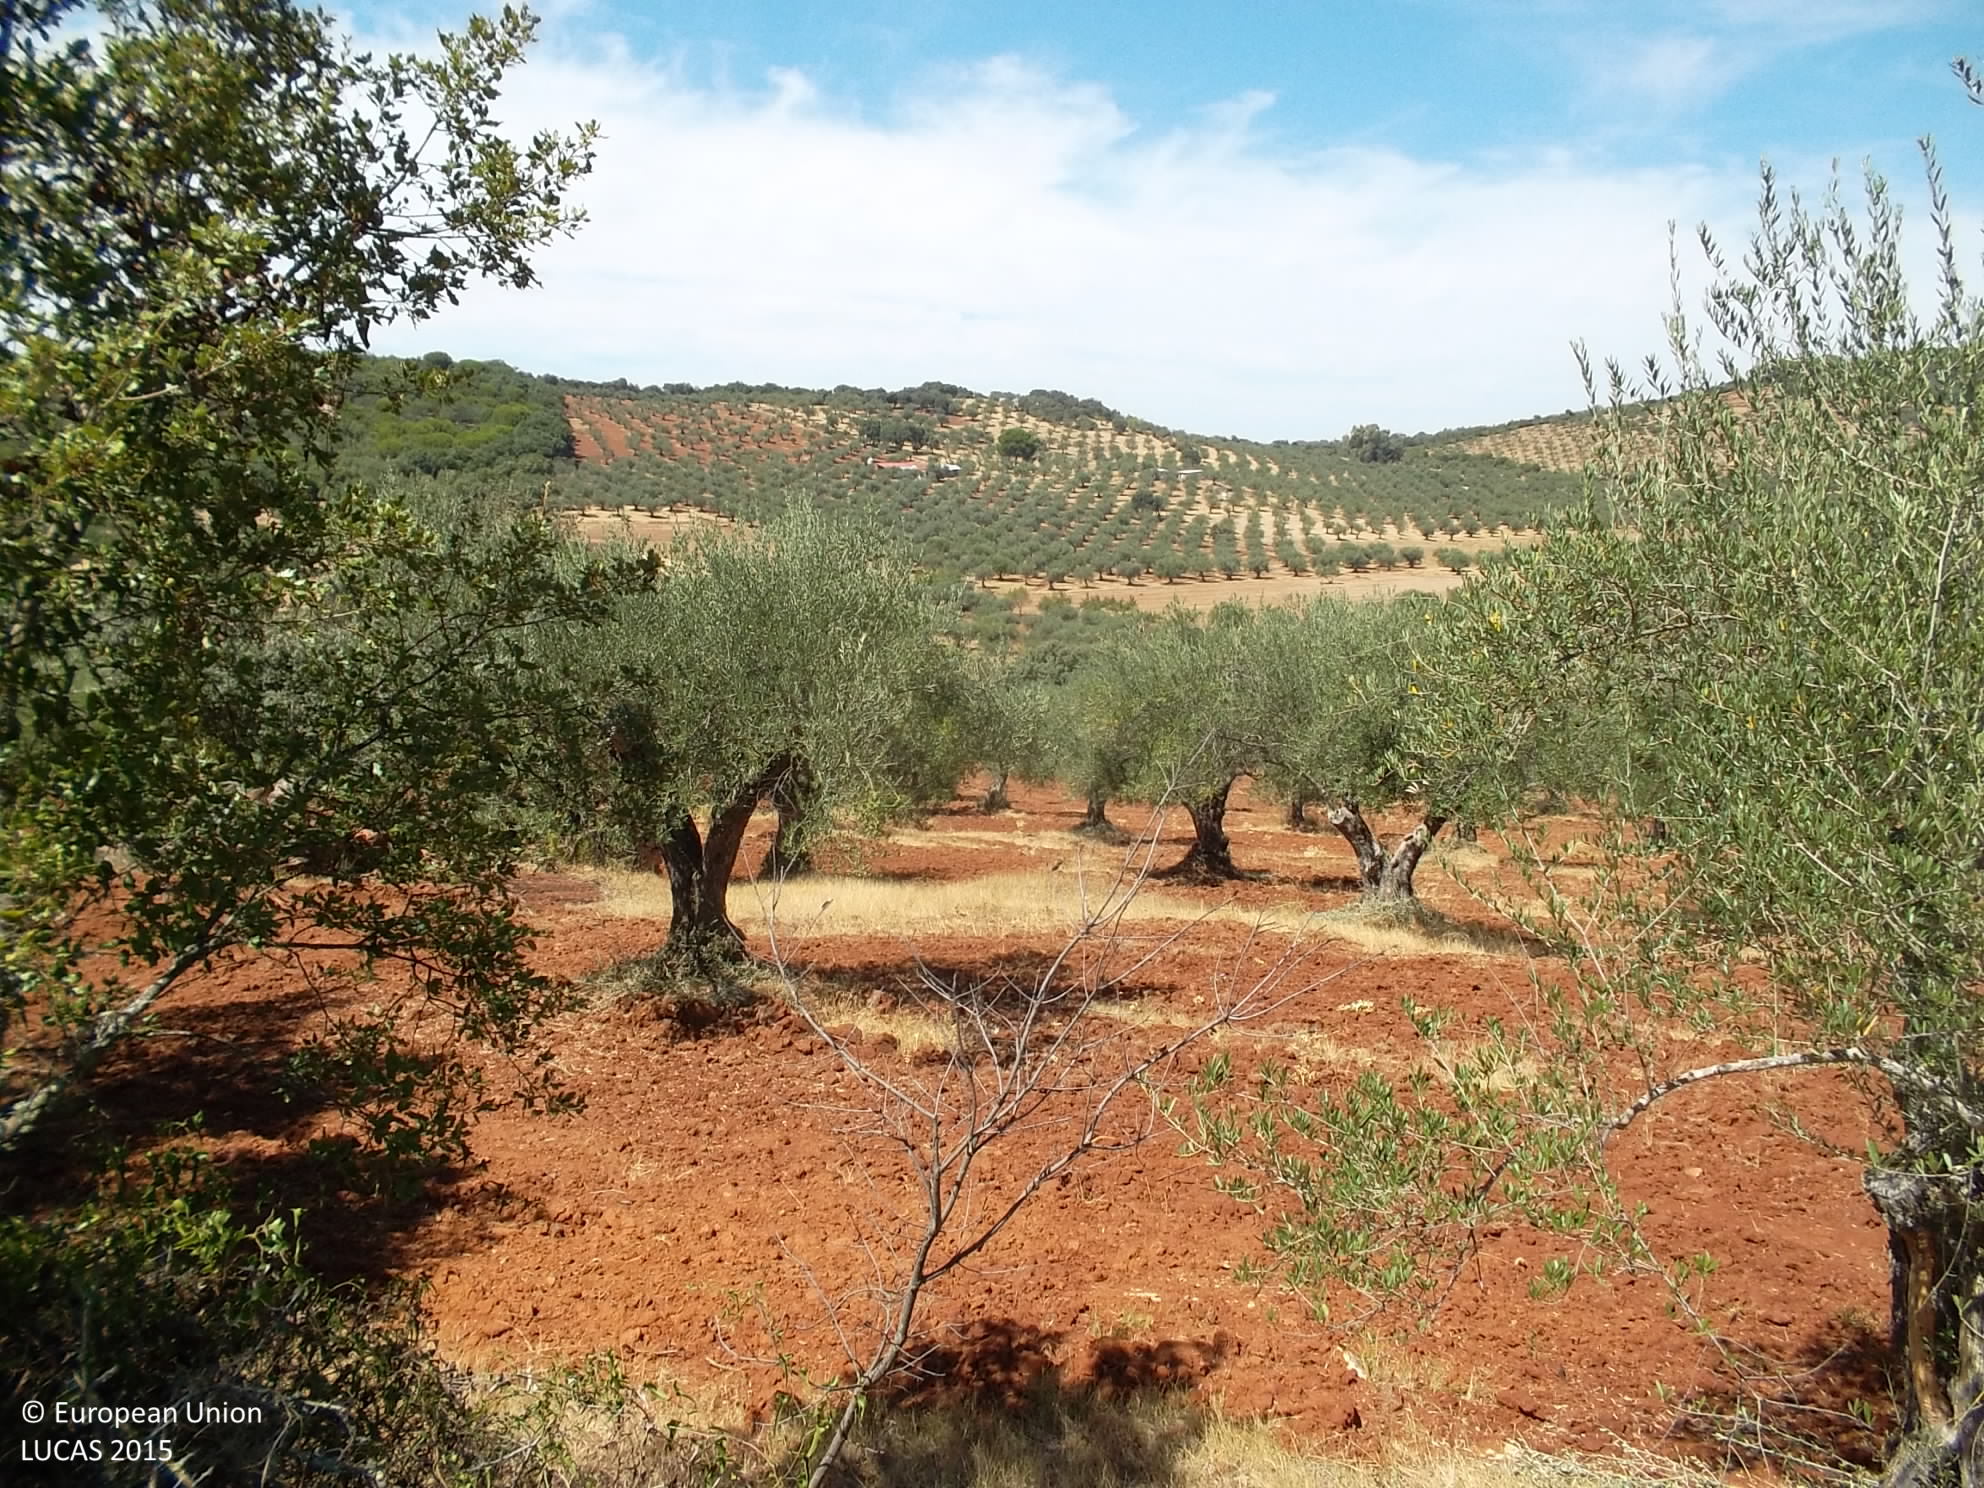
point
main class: Cropland
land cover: Olive groves
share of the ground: 10 - 25 %
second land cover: Other bare soil
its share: > 75 %
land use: Agriculture (excluding fallow land and kitchen gardens)
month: August
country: ES
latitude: 38.1603
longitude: -6.7025
